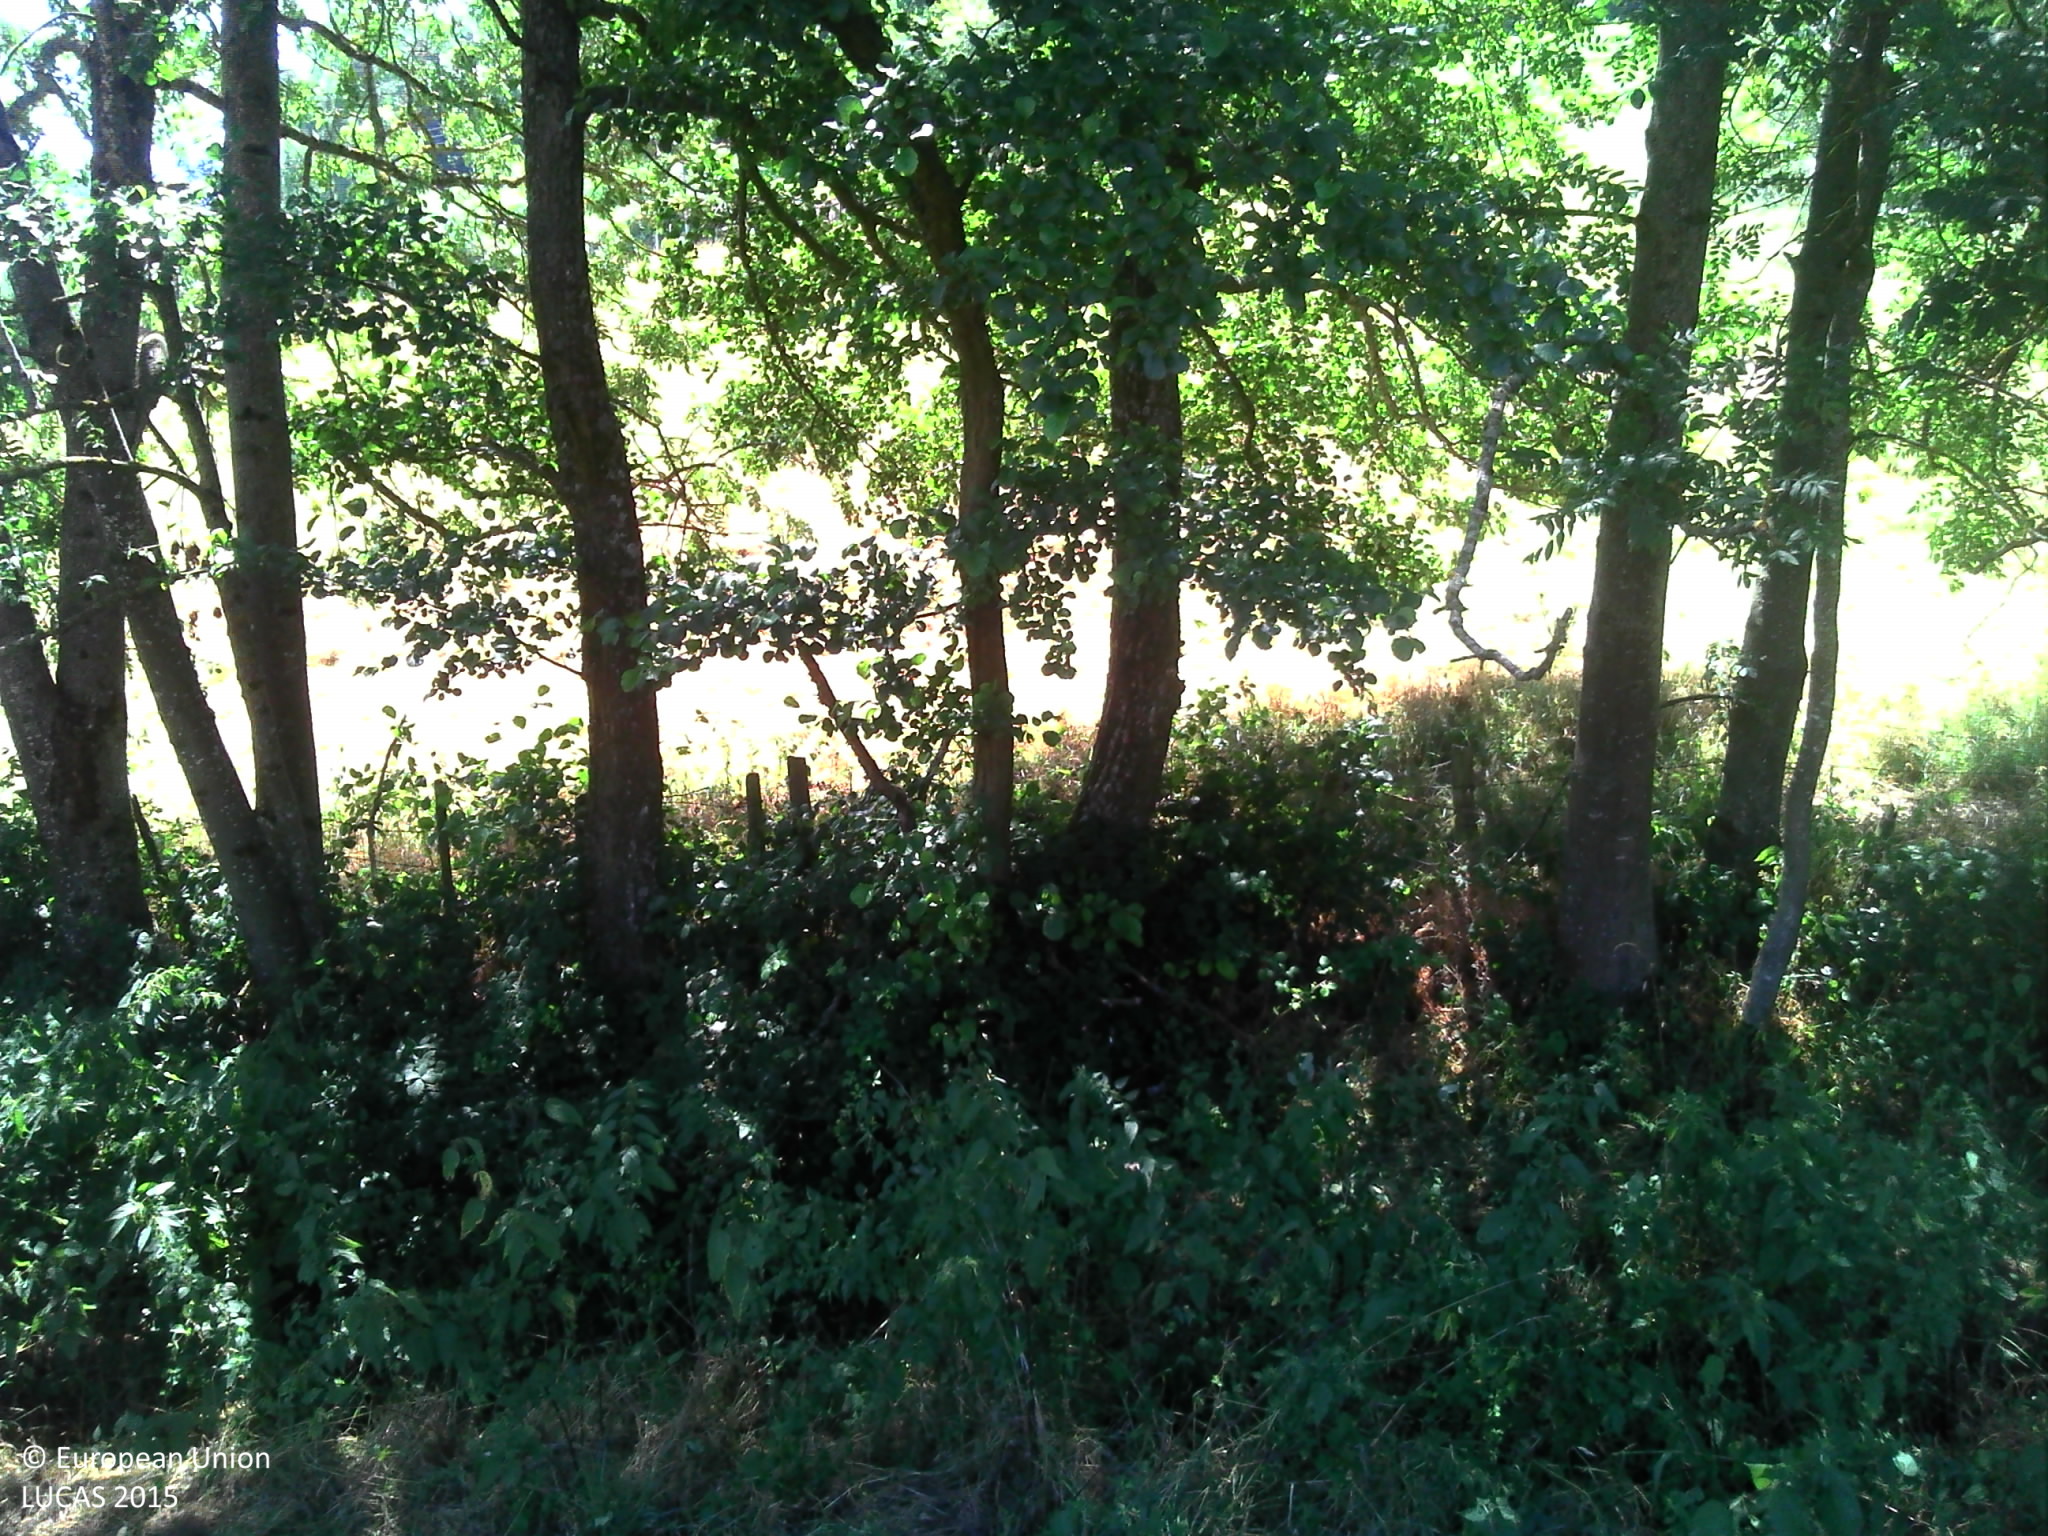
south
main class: Grassland
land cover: Grassland without tree/shrub cover
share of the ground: > 75 %
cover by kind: herbaceous plants 100 %
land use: Agriculture (excluding fallow land and kitchen gardens)
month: August
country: FR
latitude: 45.6885
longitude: 4.5461
